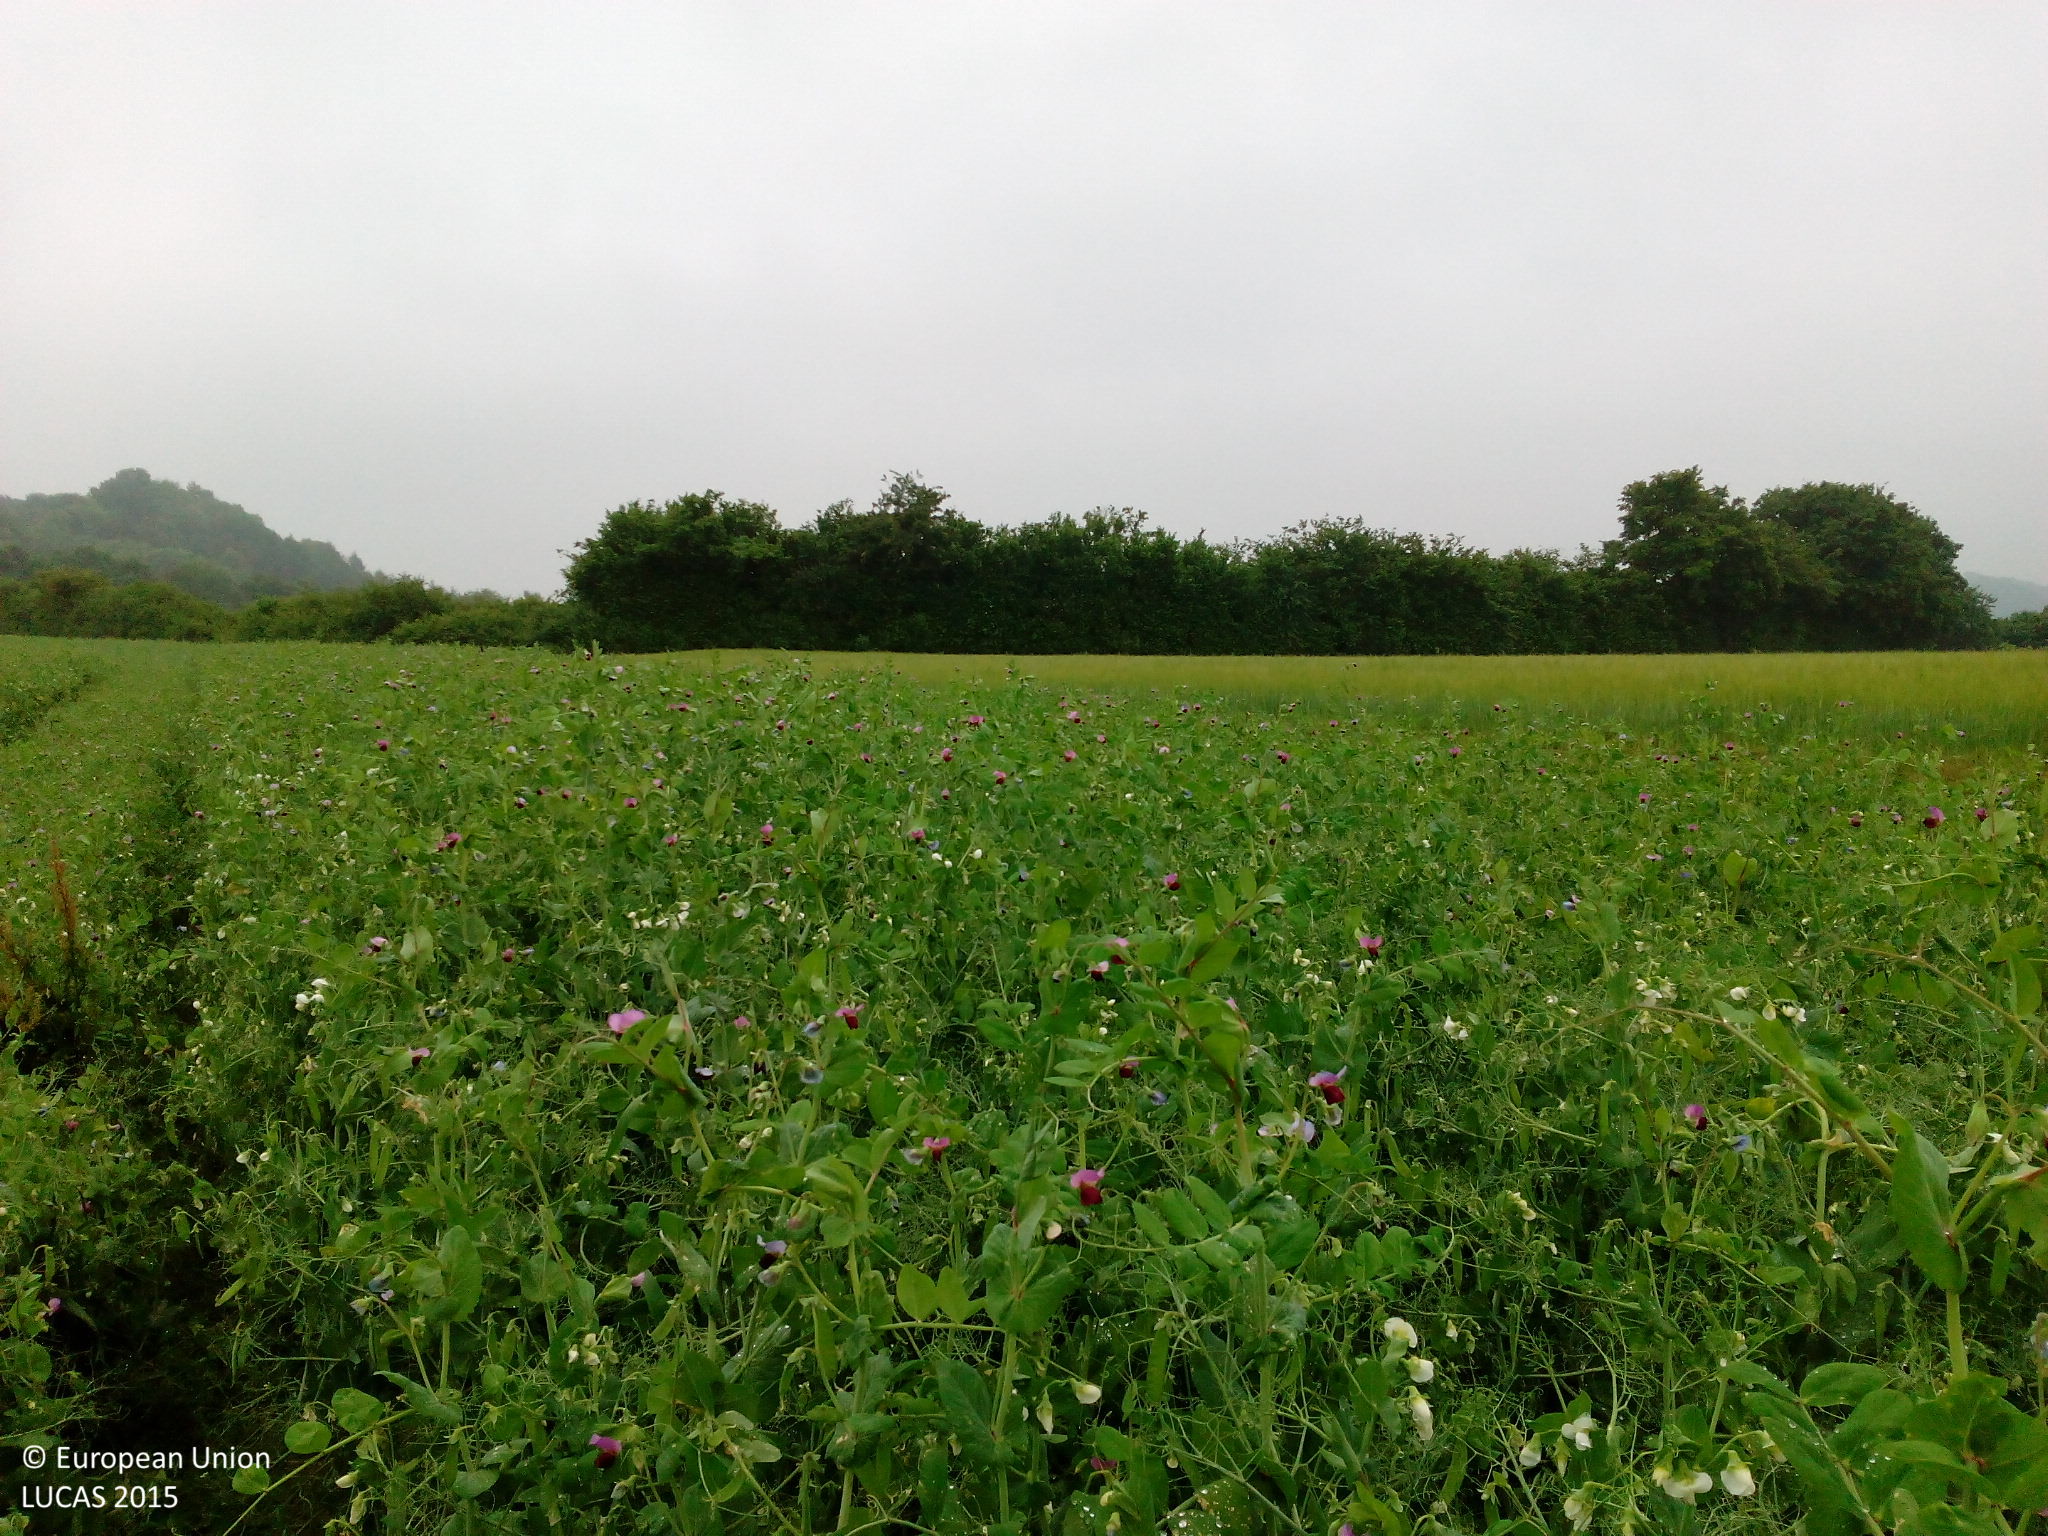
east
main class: Cropland
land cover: Dry pulses
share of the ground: > 75 %
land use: Agriculture (excluding fallow land and kitchen gardens)
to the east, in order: Dry pulses; Grass margins; Tracks; Grass margins; Barley; Grass margins; Tracks; Grass margins; Managed hedges; Common wheat; Dry pulses
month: June
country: DE
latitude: 50.1205
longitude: 11.4961
